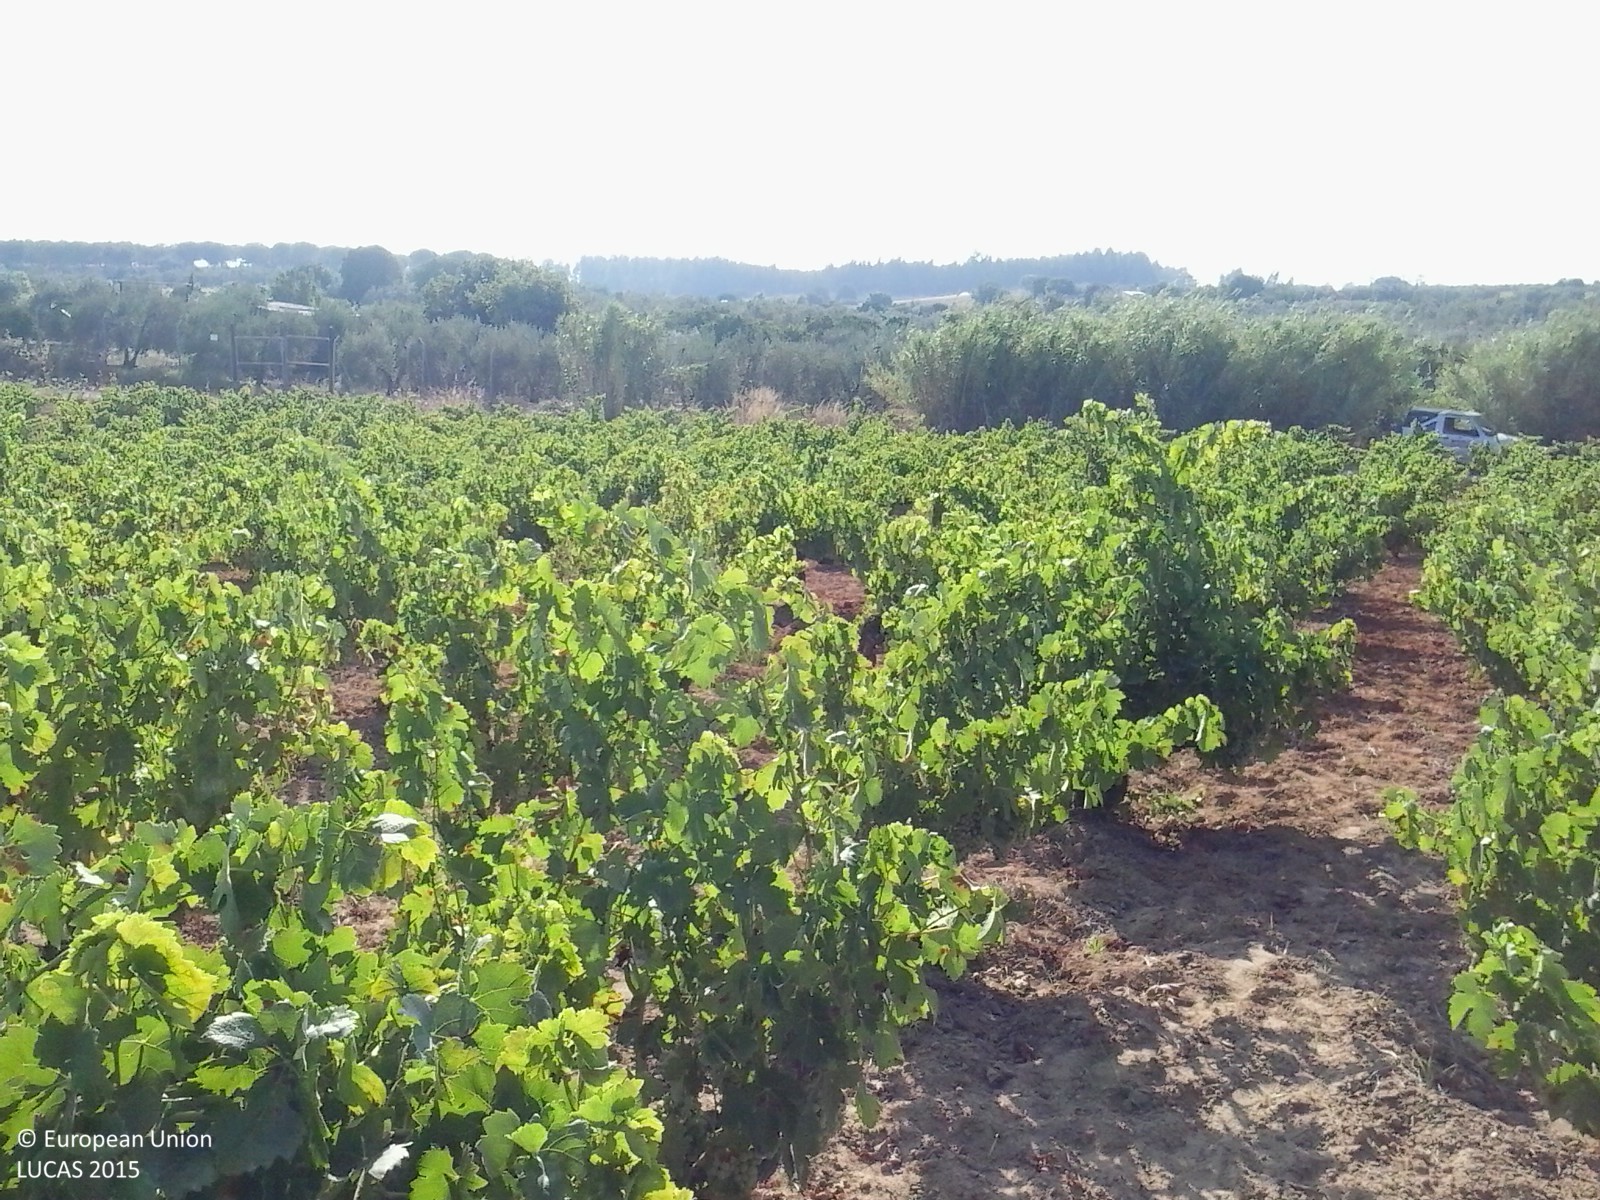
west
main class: Cropland
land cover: Vineyards
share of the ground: 10 - 25 %
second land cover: Other bare soil
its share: > 75 %
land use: Agriculture (excluding fallow land and kitchen gardens)
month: June
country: ES
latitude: 37.3727
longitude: -6.4619
